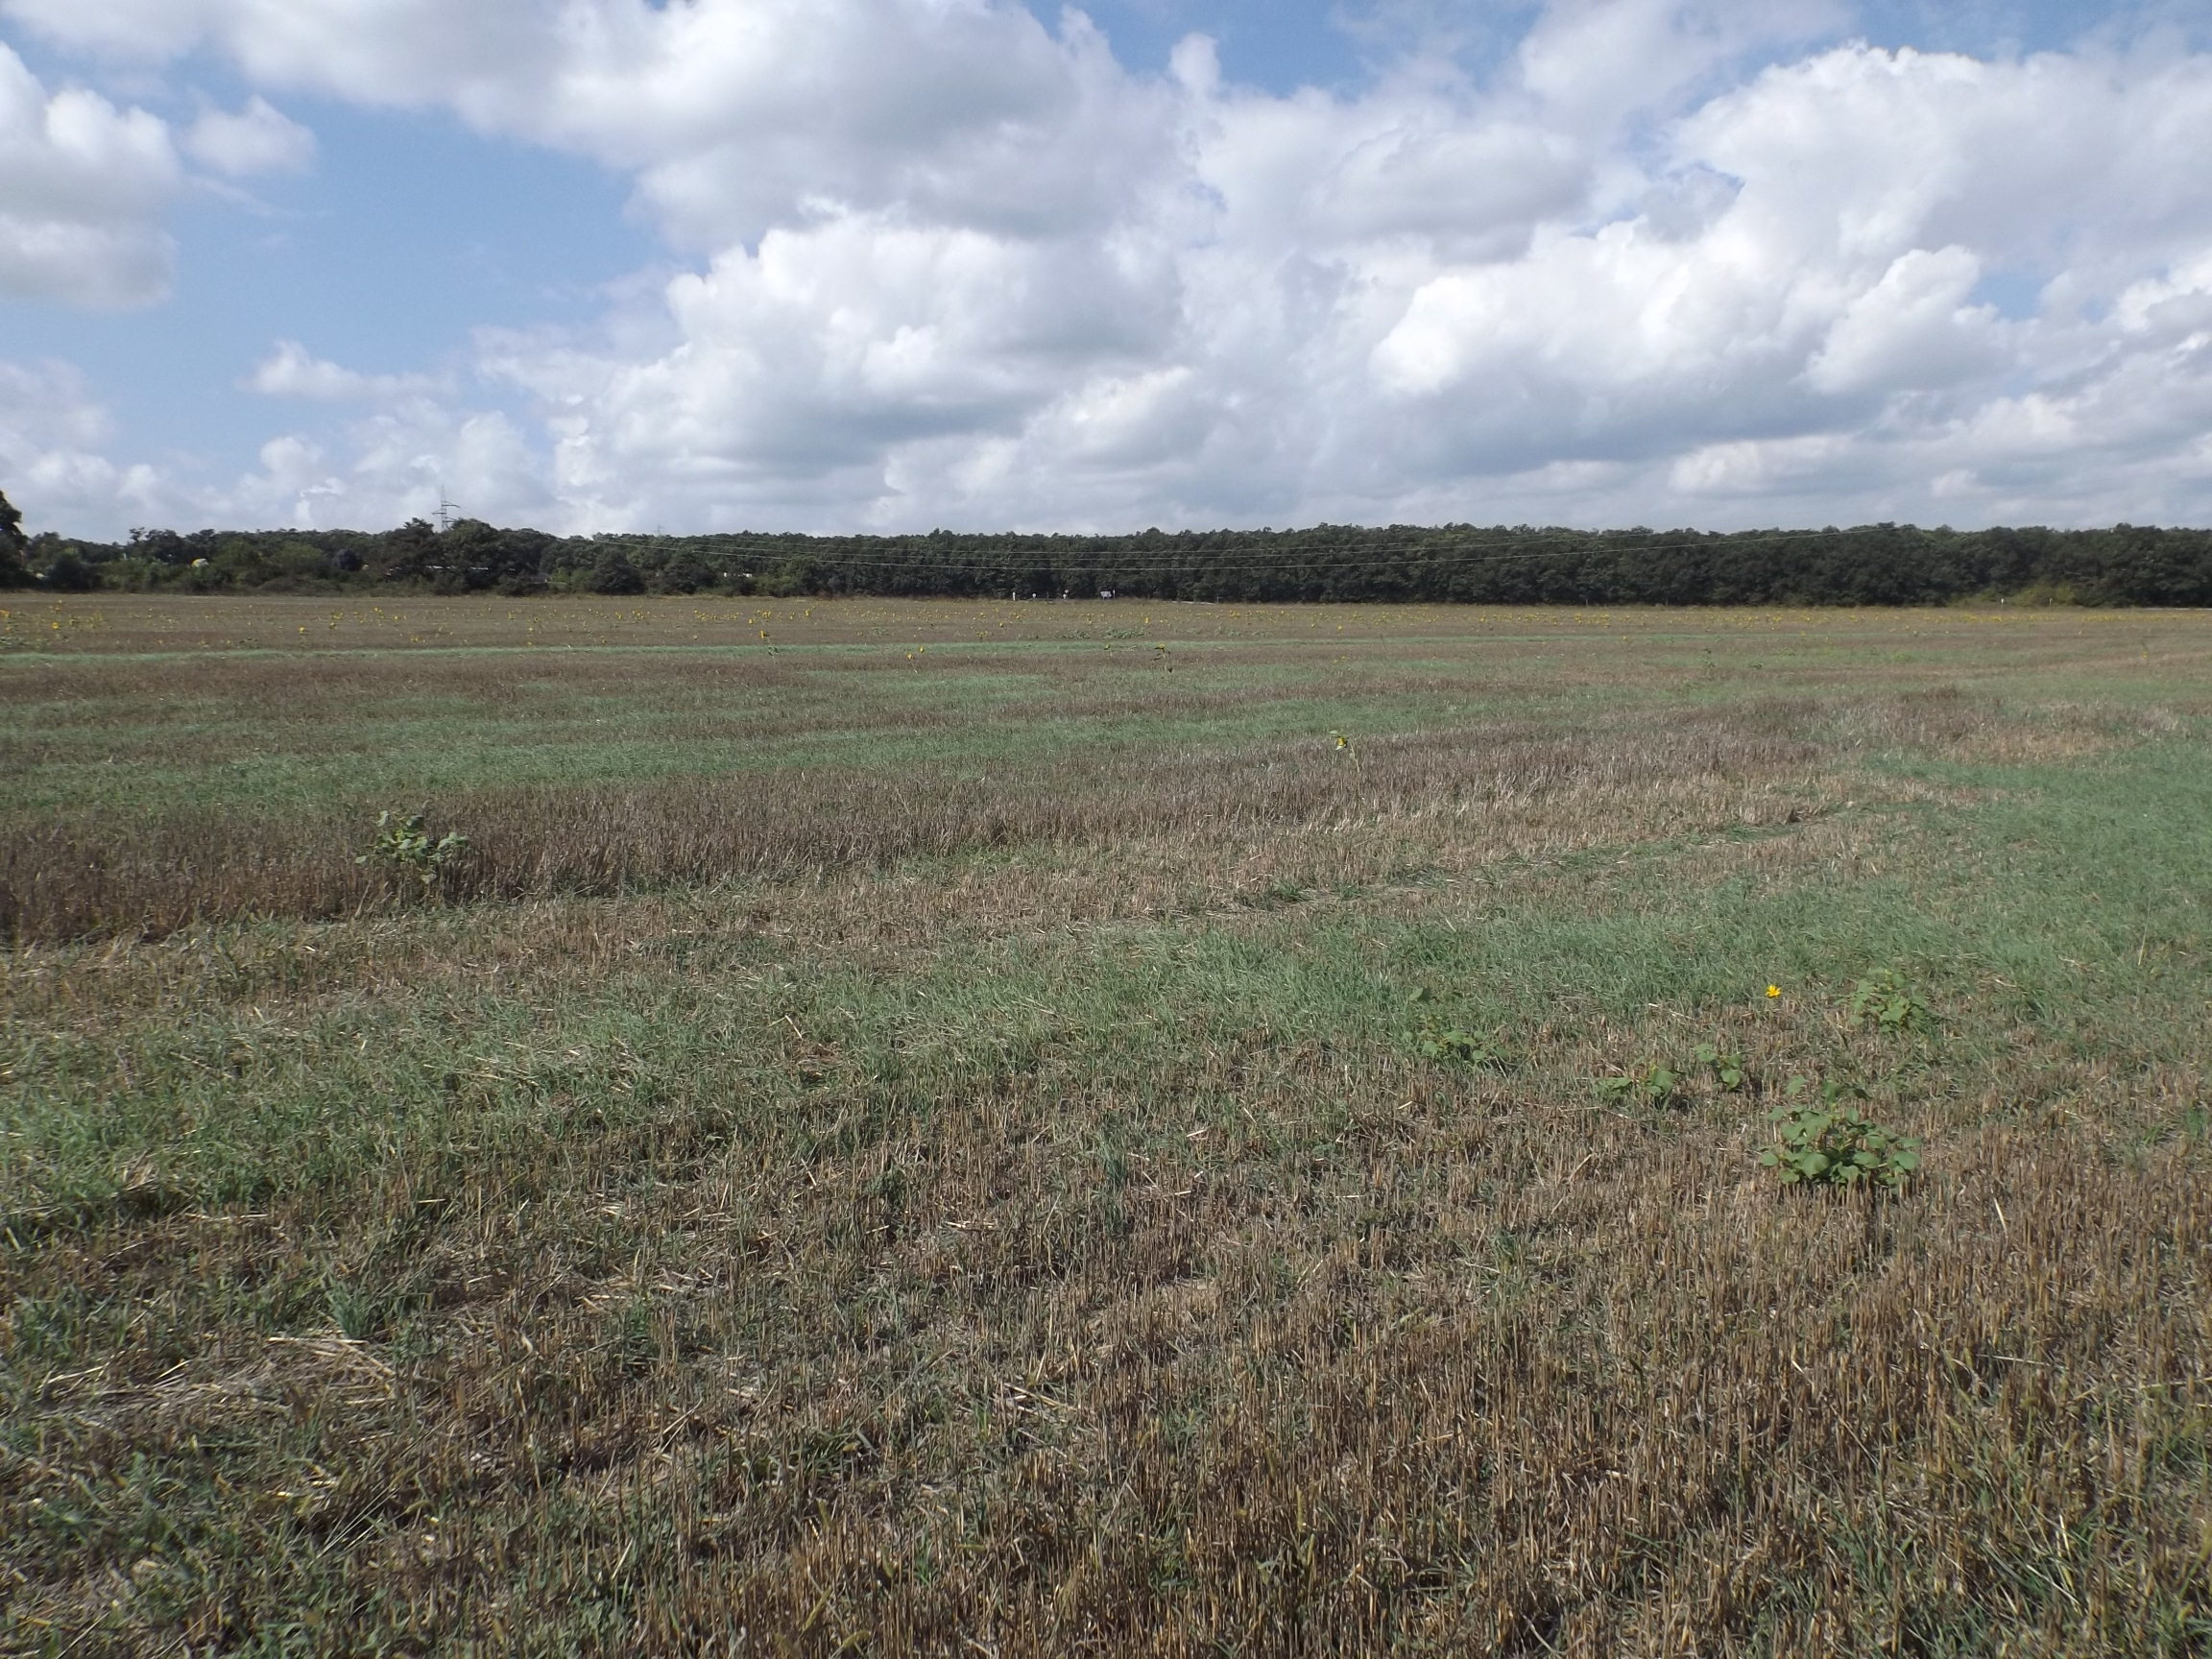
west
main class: Cropland
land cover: Common wheat
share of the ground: 25 - 50 %
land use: Agriculture (excluding fallow land and kitchen gardens)
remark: Harvested field
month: September
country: BG
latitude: 43.0282
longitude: 27.8437
